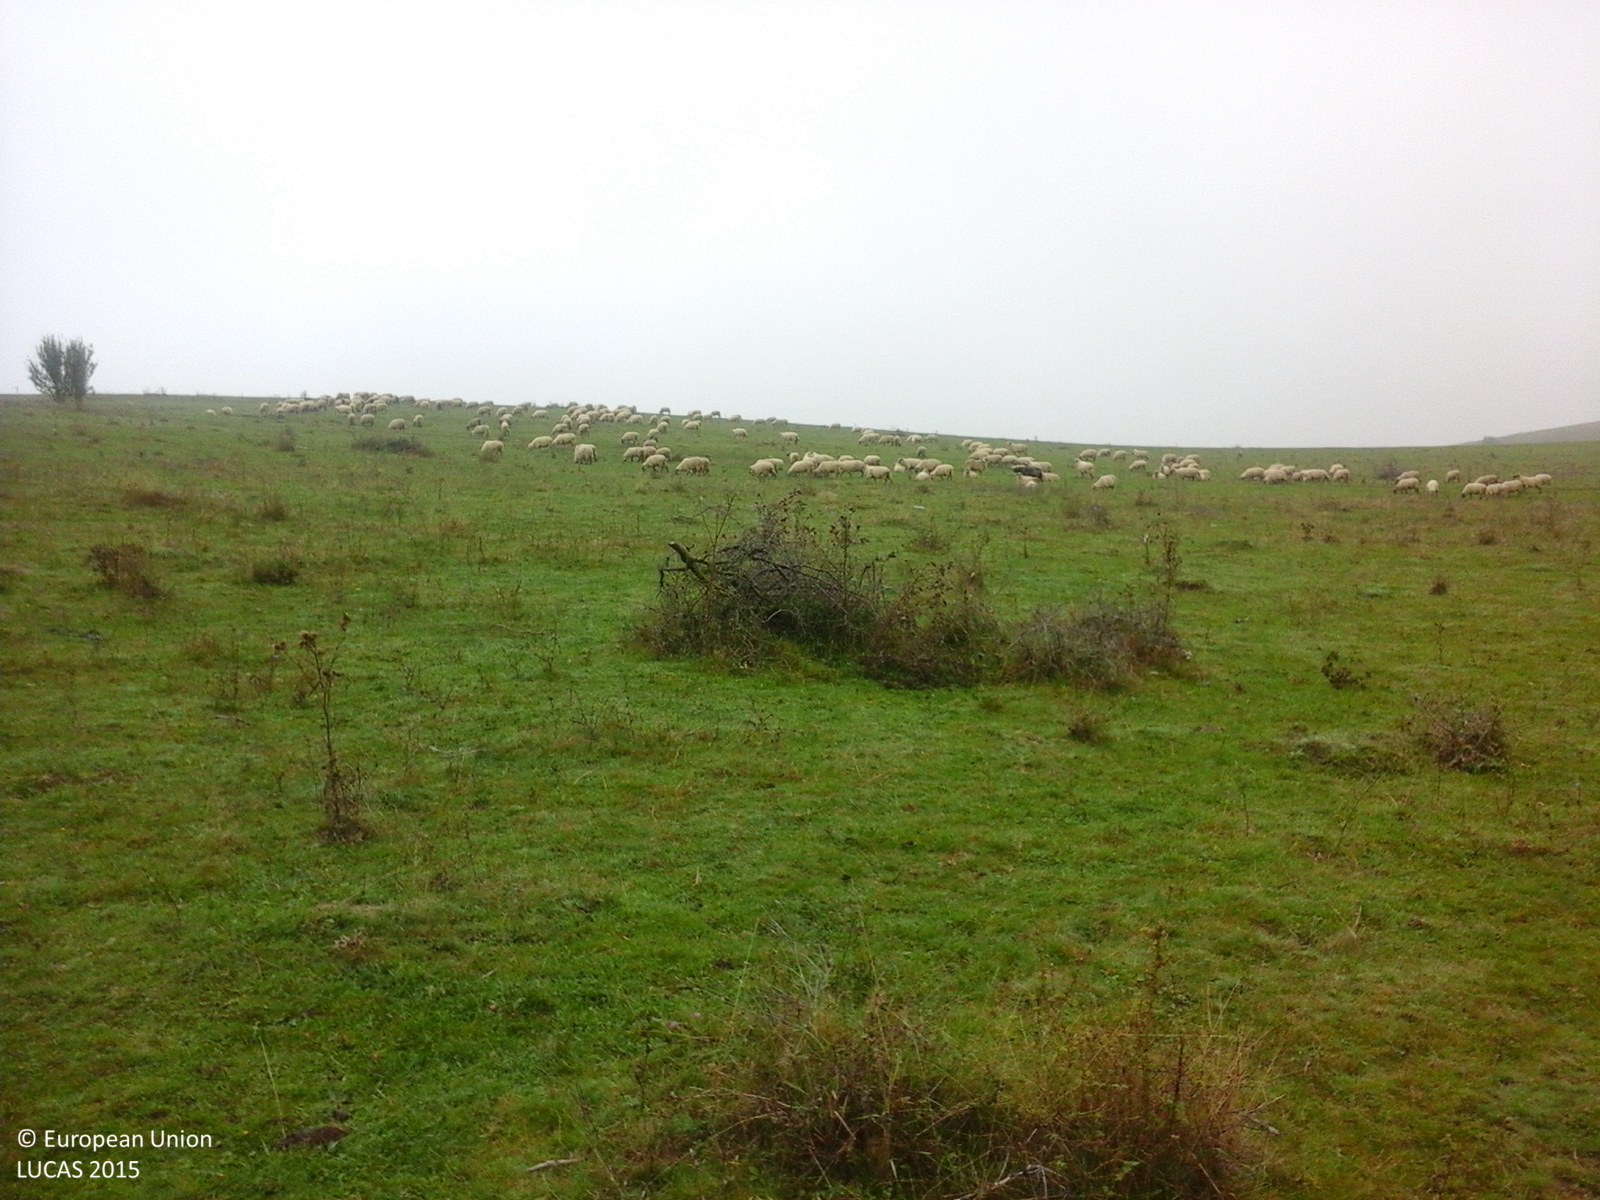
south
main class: Grassland
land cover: Grassland with sparse tree/shrub cover
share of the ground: > 75 %
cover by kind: herbaceous plants 95 %, broadleaved forest trees 5 %
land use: Agriculture (excluding fallow land and kitchen gardens)
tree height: < 5 m
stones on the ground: < 10 %
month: October
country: RO
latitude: 46.6723
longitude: 24.3726
